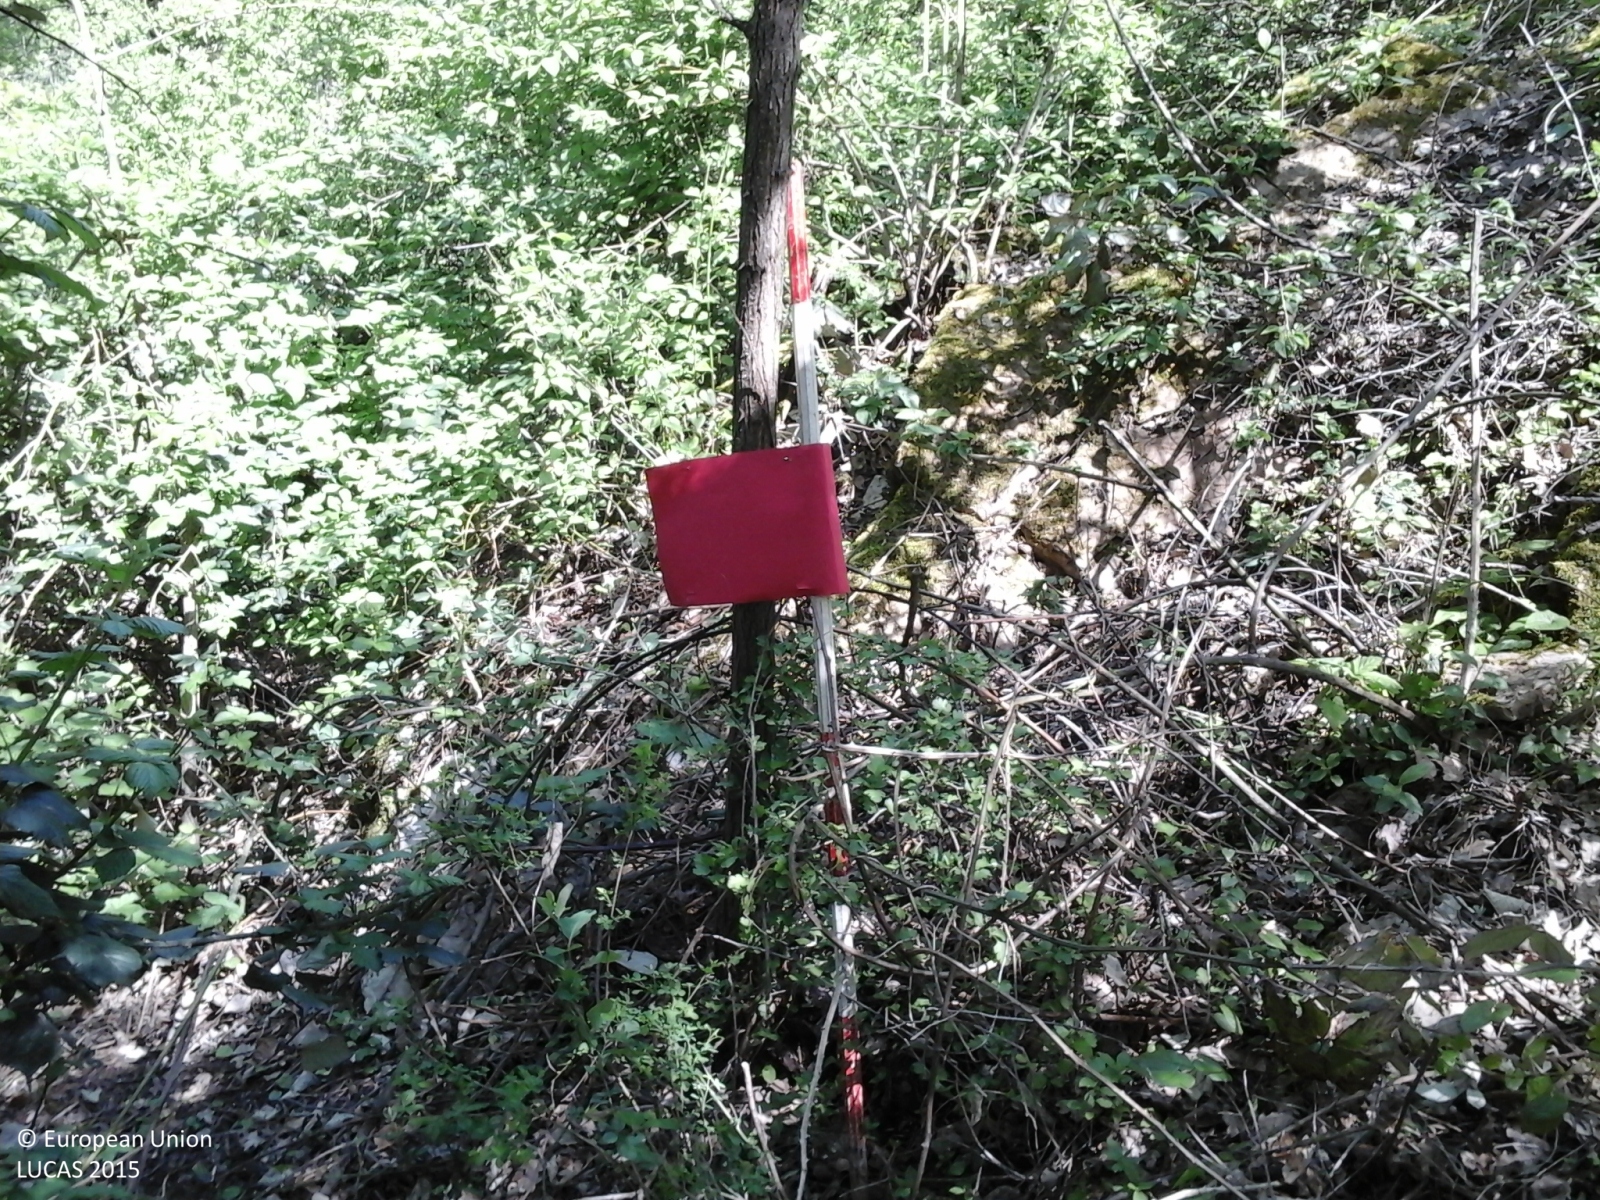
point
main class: Woodland
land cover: Broadleaved woodland
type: thermophilous deciduous forest
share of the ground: > 75 %
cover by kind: broadleaved forest trees 60 %, shrubs 30 %, herbaceous plants 10 %
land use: Forestry
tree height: > 5 m
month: April
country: IT
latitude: 44.9433
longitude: 9.3043
